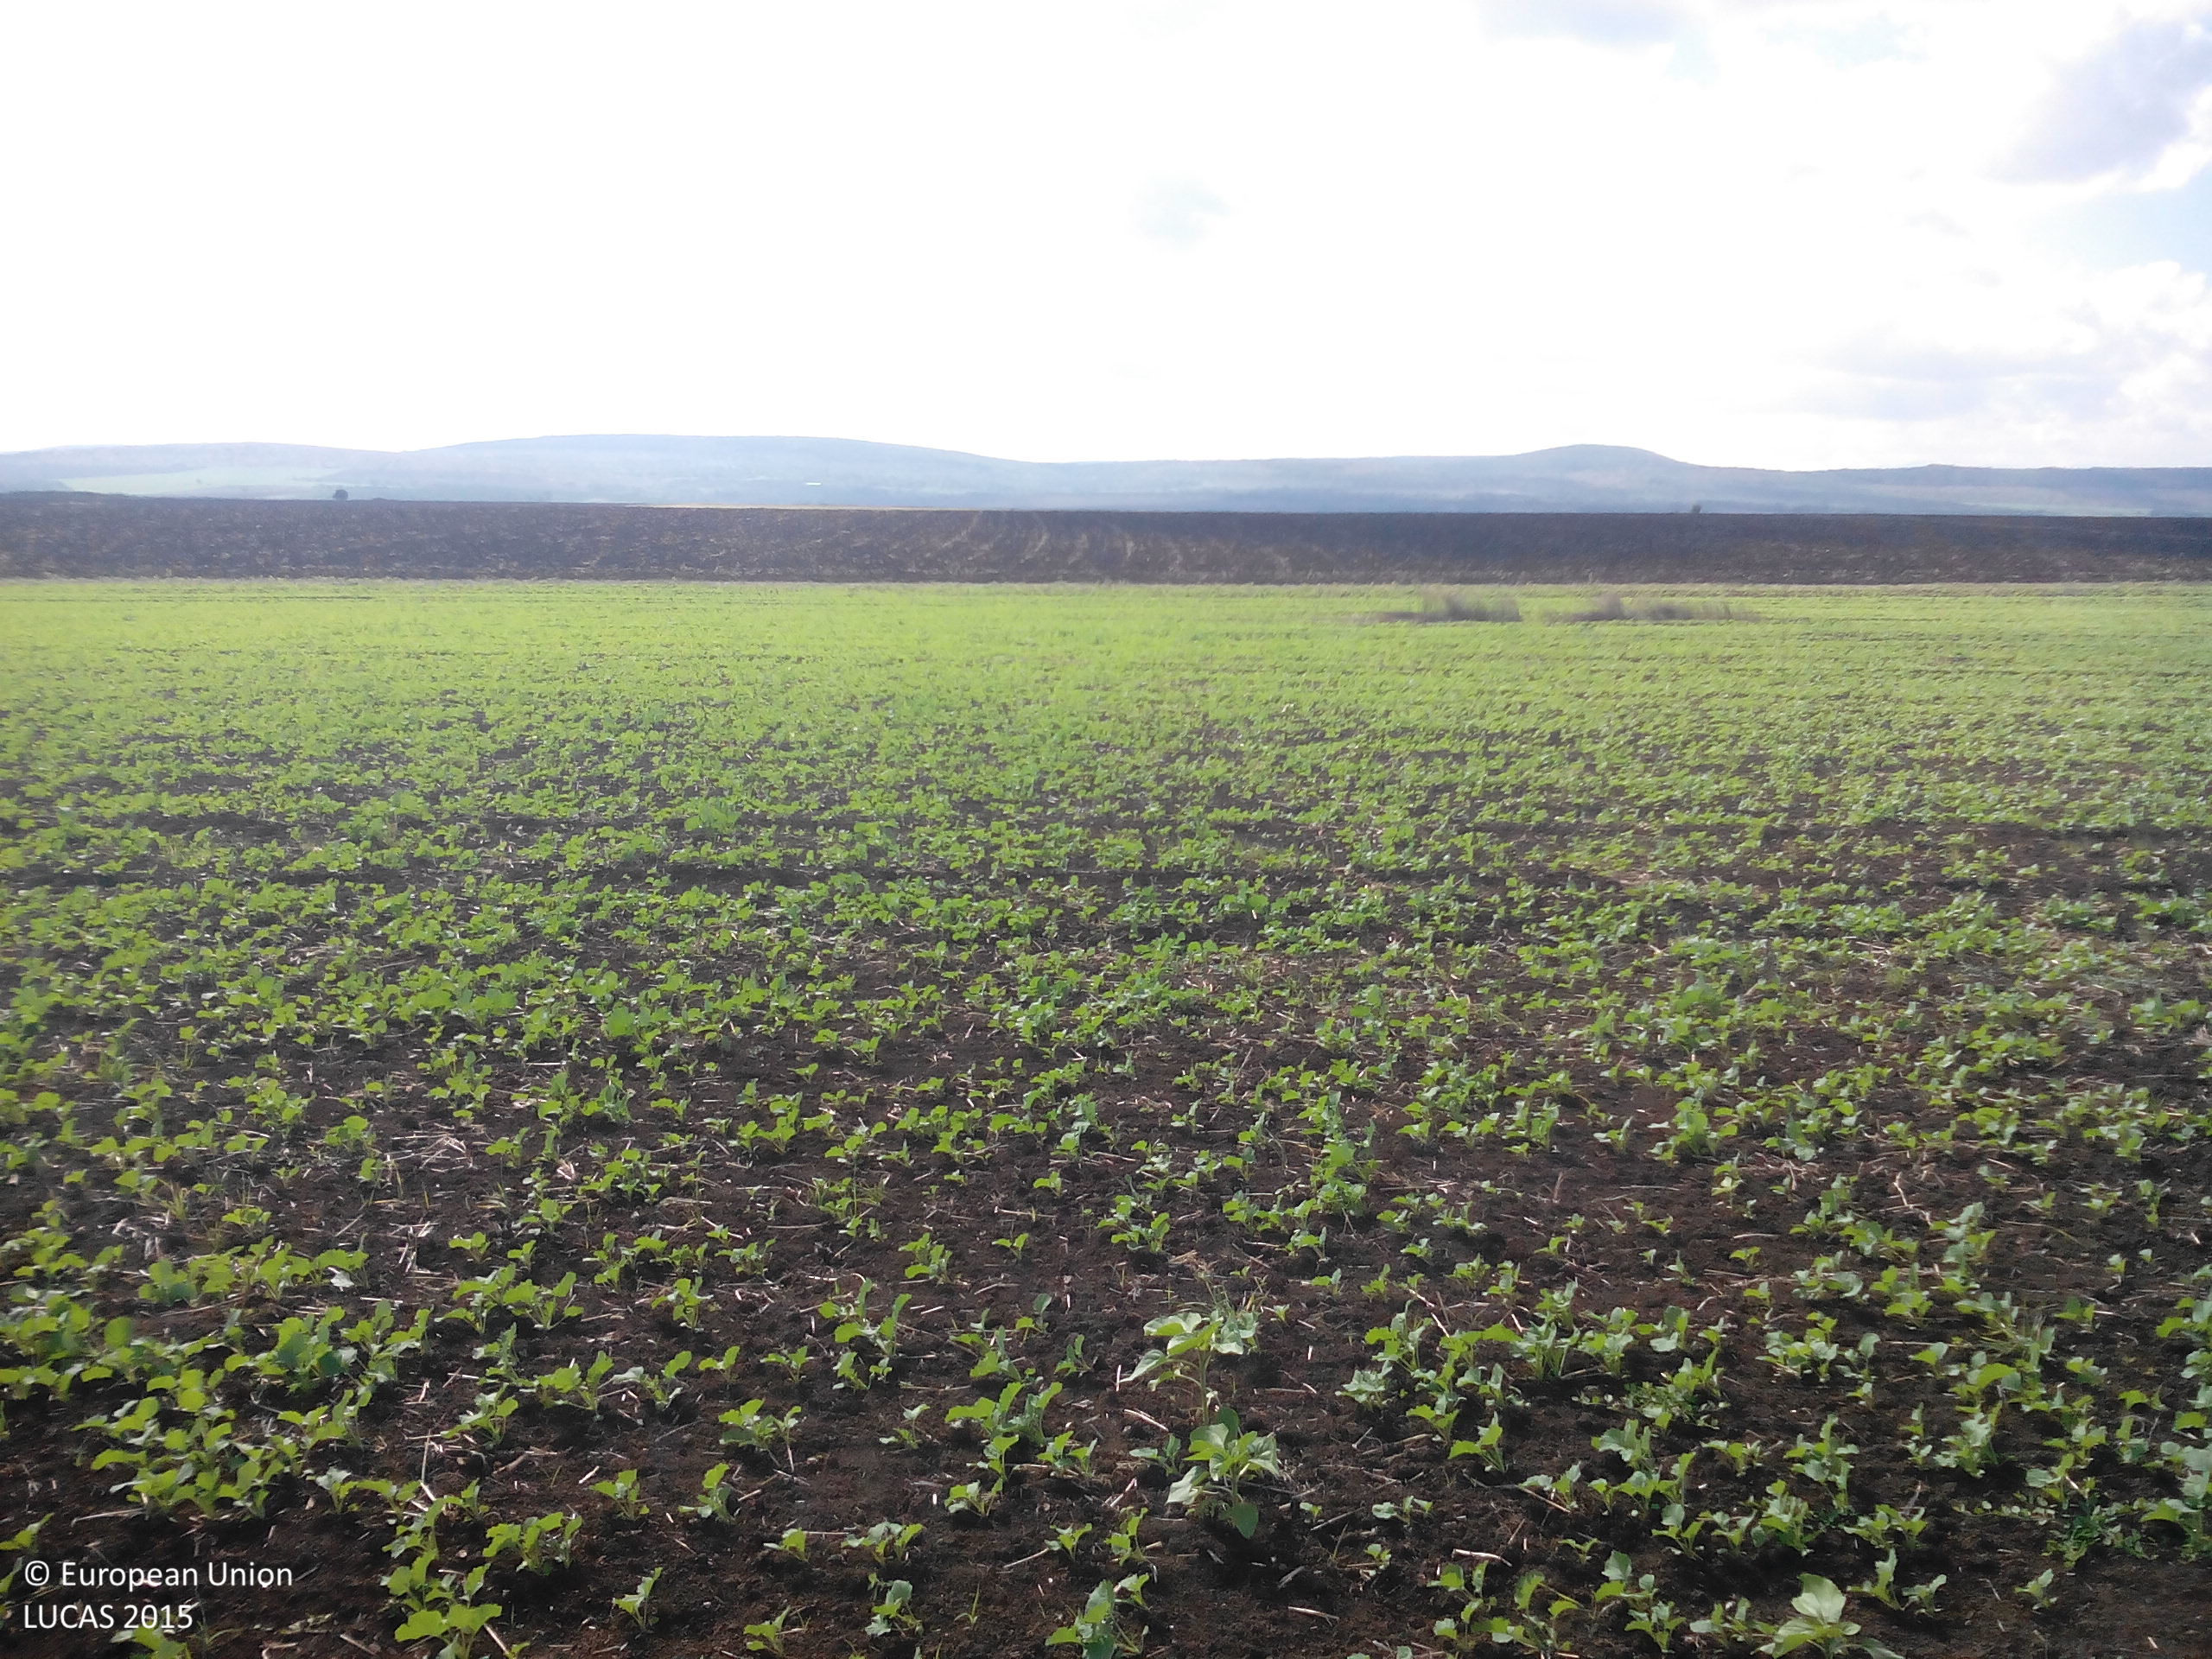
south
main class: Cropland
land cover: Rape and turnip rape
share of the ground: 25 - 50 %
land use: Agriculture (excluding fallow land and kitchen gardens)
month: October
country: BG
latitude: 43.3996
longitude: 23.8408
